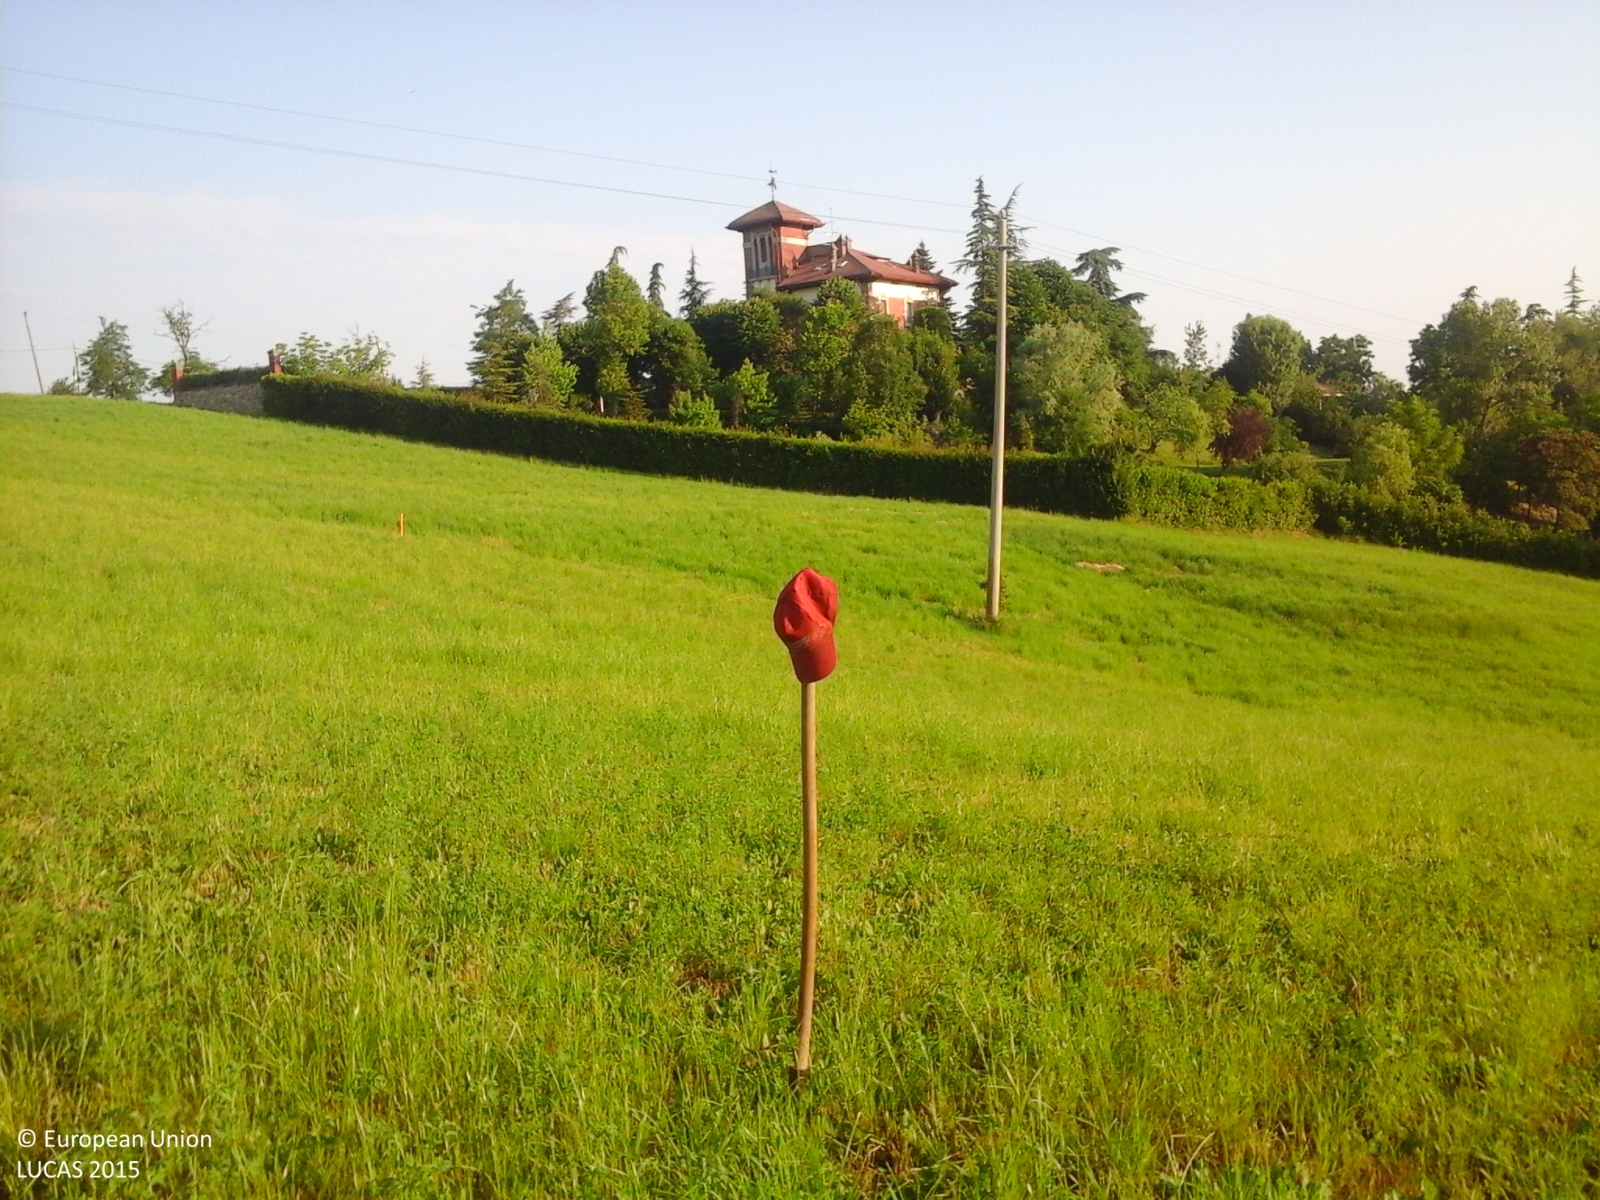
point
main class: Cropland
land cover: Lucerne
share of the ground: > 75 %
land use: Agriculture (excluding fallow land and kitchen gardens)
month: June
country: IT
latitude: 44.8194
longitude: 9.9621
